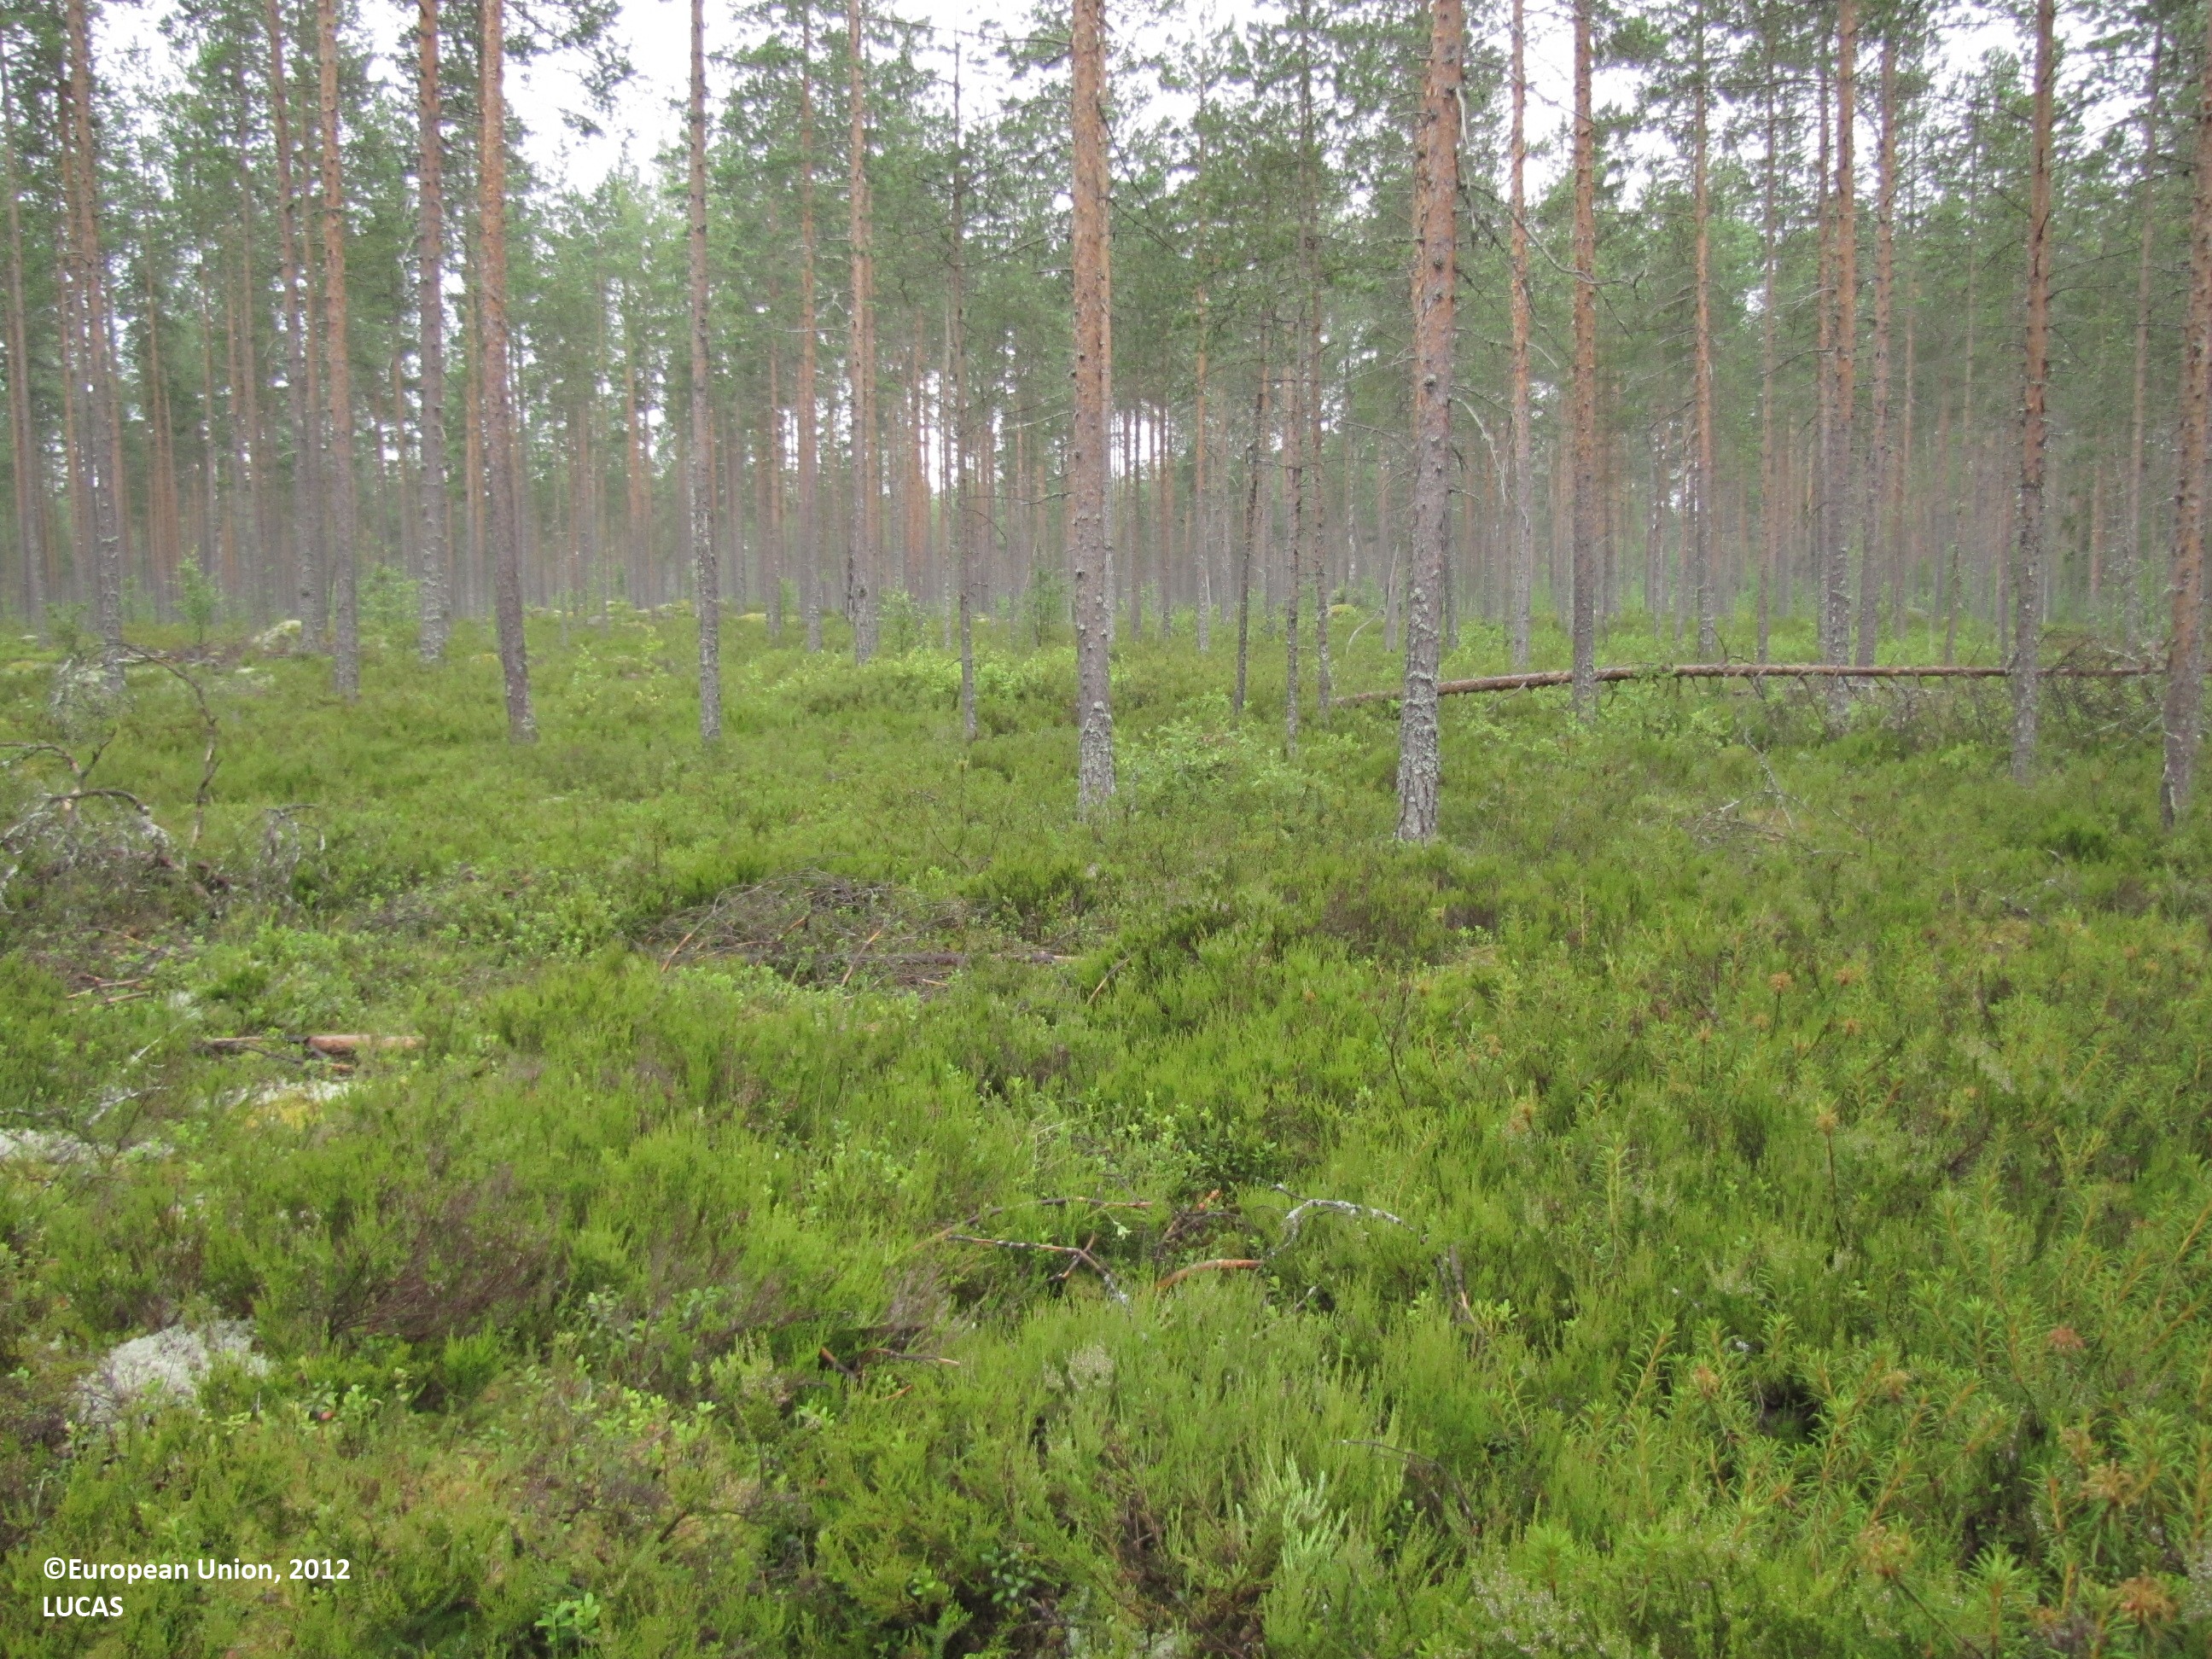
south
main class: Woodland
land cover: Pine dominated coniferous woodland
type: boreal forest
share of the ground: 50 - 75 %
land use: Forestry
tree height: > 5 m
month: July
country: FI
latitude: 62.0866
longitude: 22.9524
